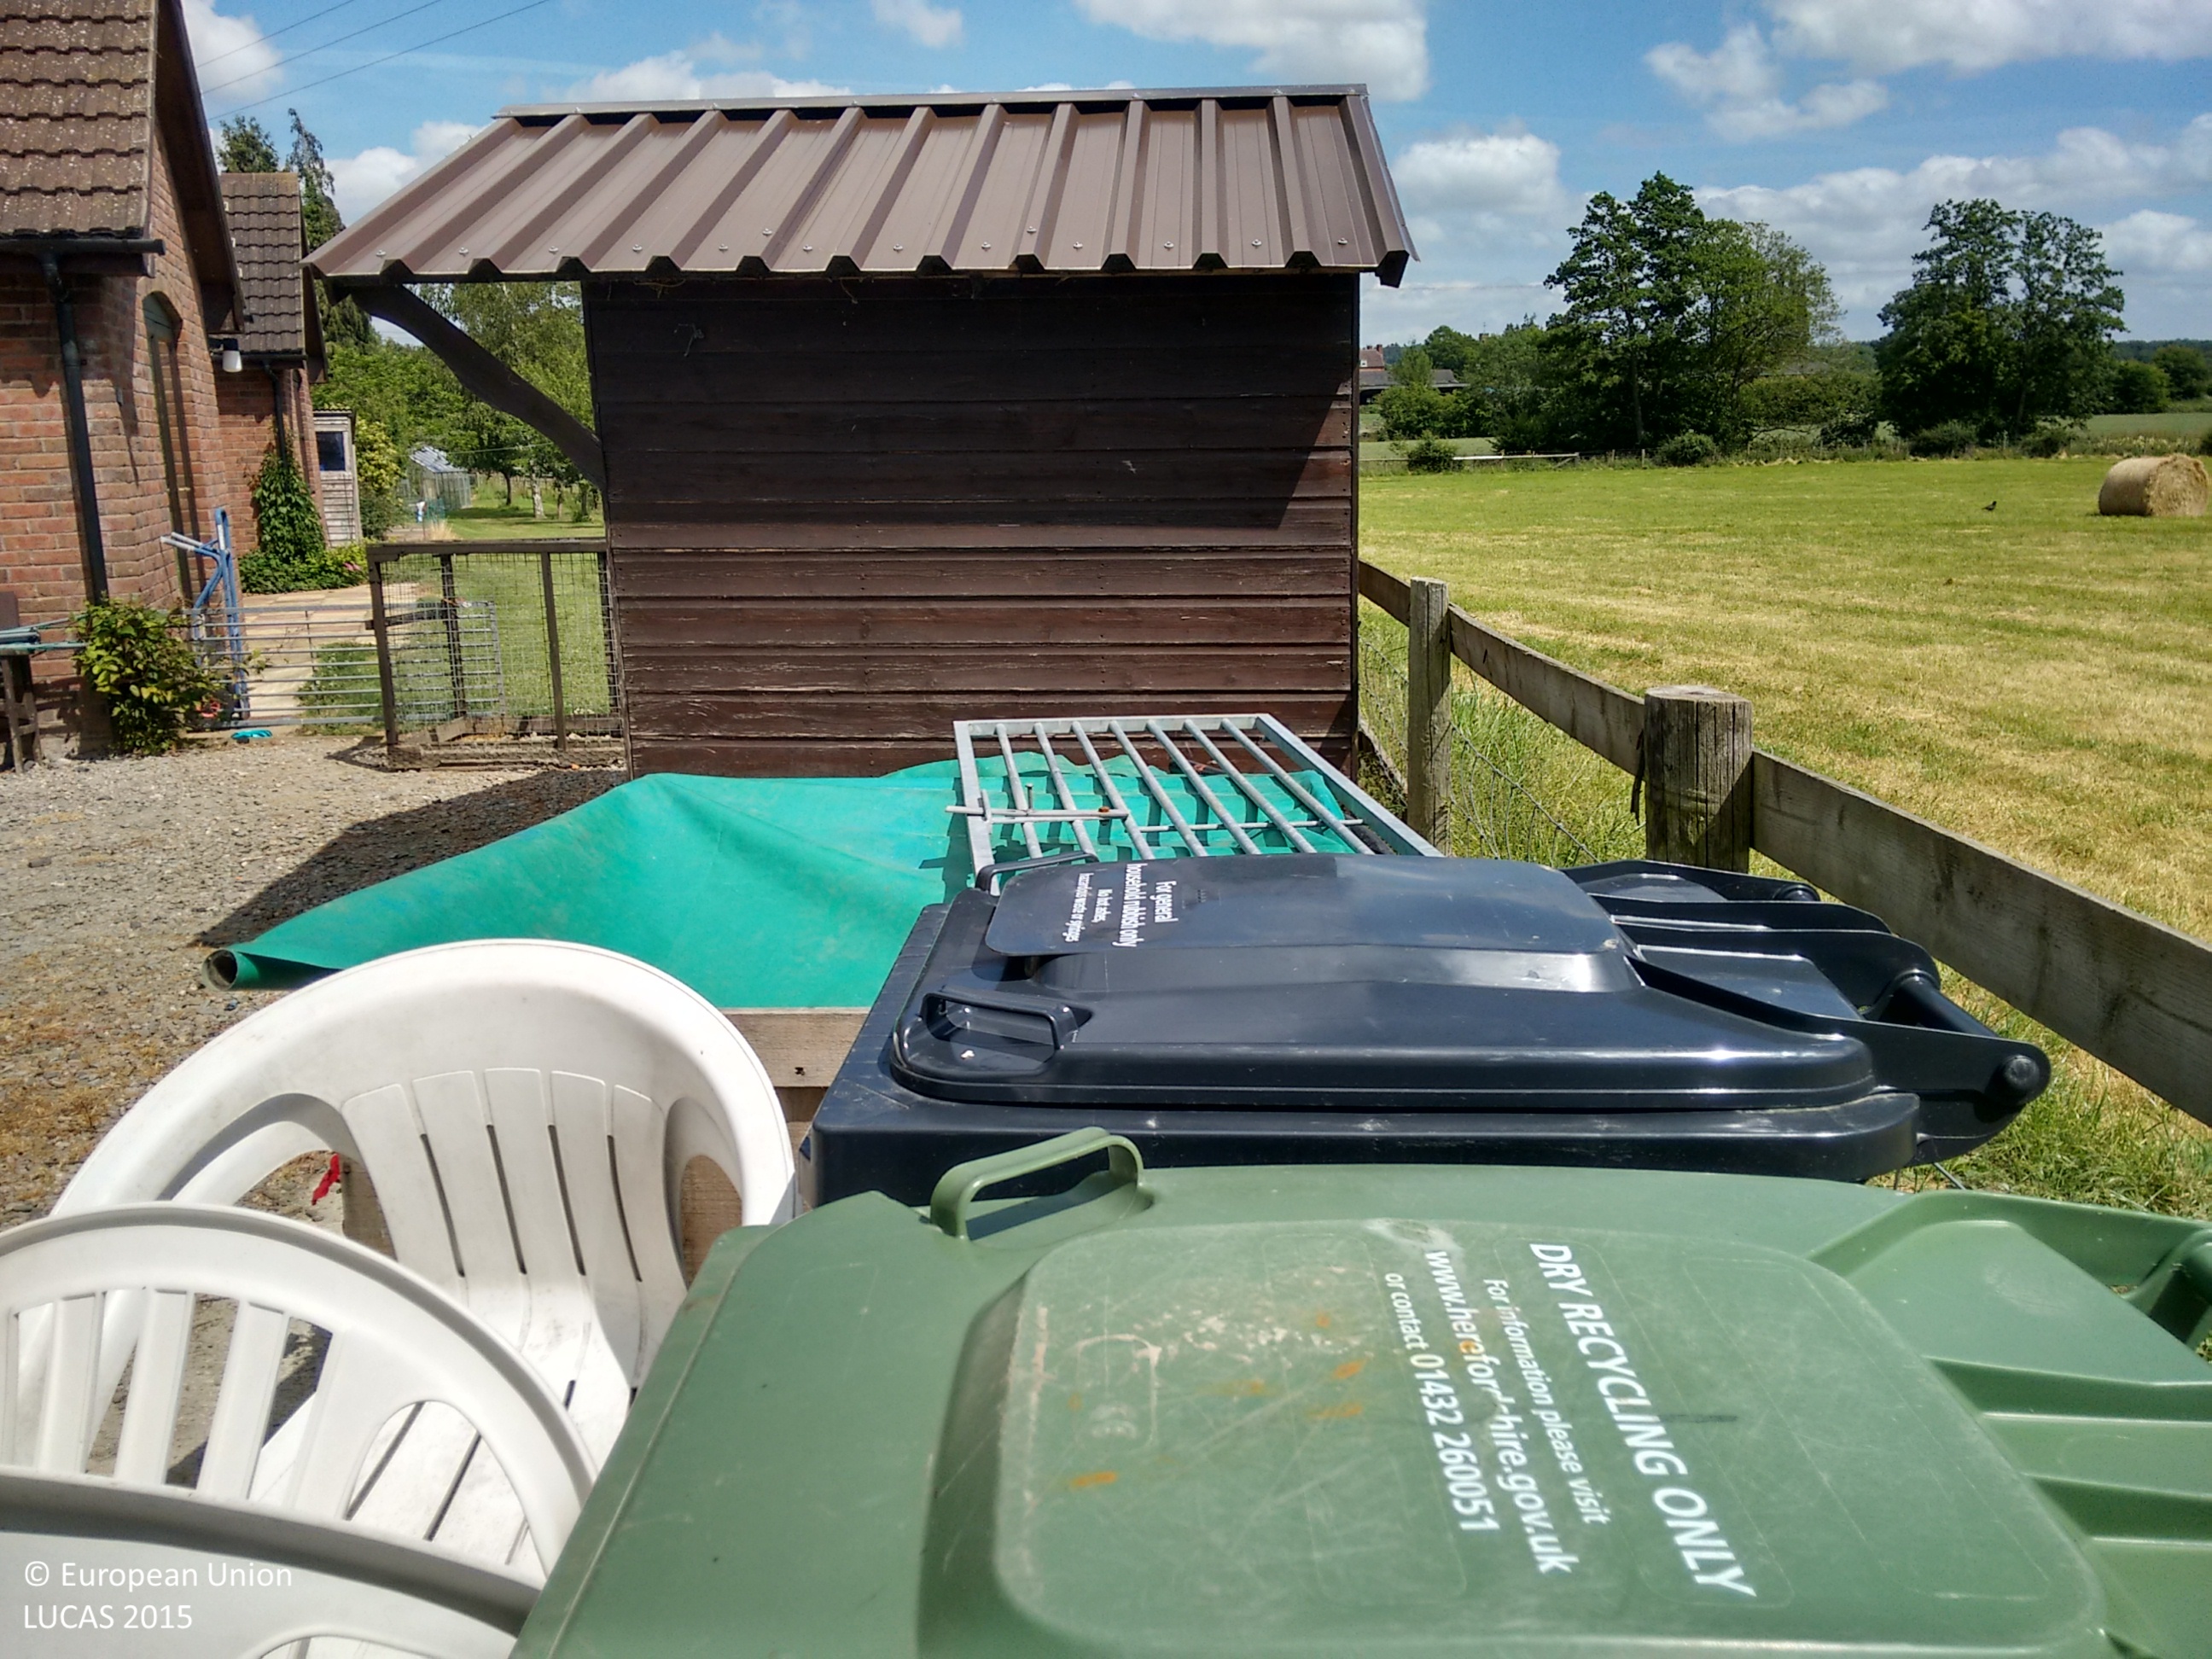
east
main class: Grassland
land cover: Grassland without tree/shrub cover
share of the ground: > 75 %
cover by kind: herbaceous plants 100 %
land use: Agriculture (excluding fallow land and kitchen gardens)
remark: Harvested field
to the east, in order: Grassland without tree/shrub cover; Fences; Grass margins; Rivers and streams; Grass margins; Fences; Grass margins; Tracks; Common wheat; Electric lines; Common wheat; Fences; Managed hedges; Railways; Managed hedges; Fences; Grassland without tree/shrub cover; Fences; Grassland without tree/shrub cover; Tracks; Fences; Grassland without tree/shrub cover
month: June
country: GB
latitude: 52.2695
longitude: -2.7464
